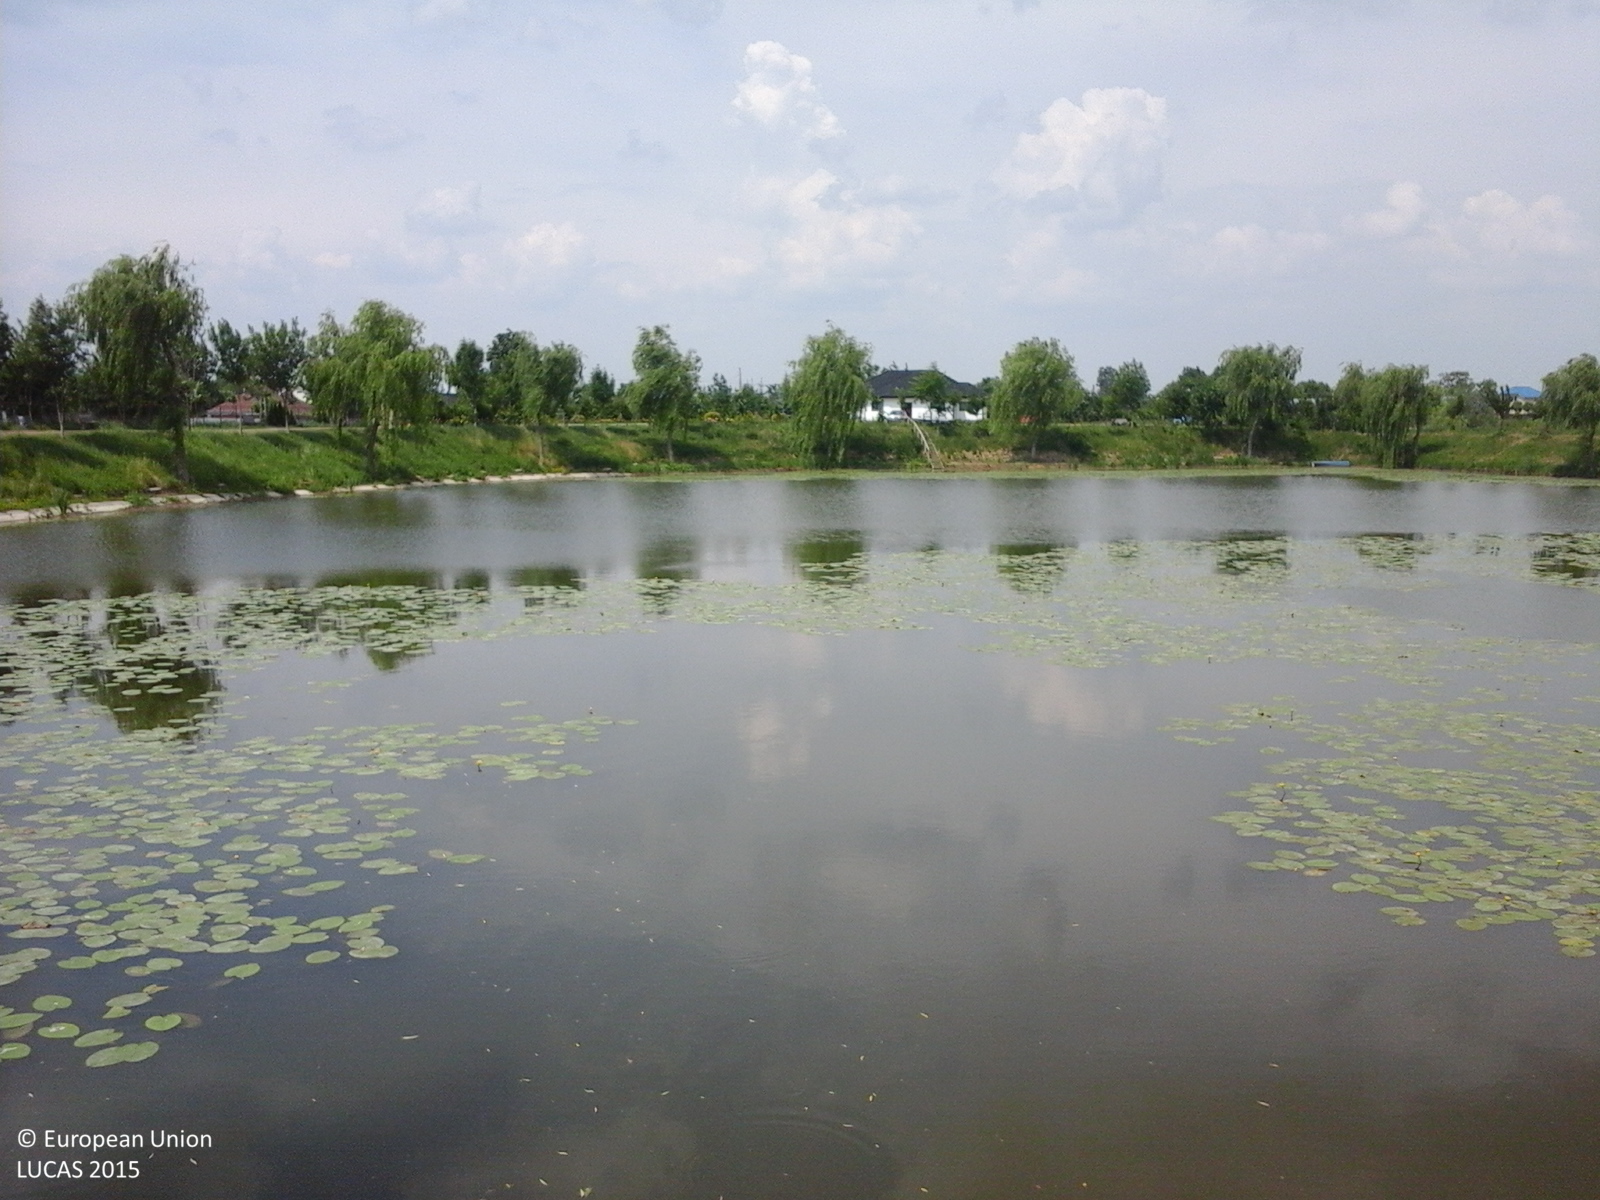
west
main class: Grassland
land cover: Grassland with sparse tree/shrub cover
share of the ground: > 75 %
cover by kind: herbaceous plants 90 %, broadleaved forest trees 5 %, shrubs 5 %
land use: Amenities, museums, leisure
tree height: > 5 m
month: June
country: RO
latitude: 46.9307
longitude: 26.9759
